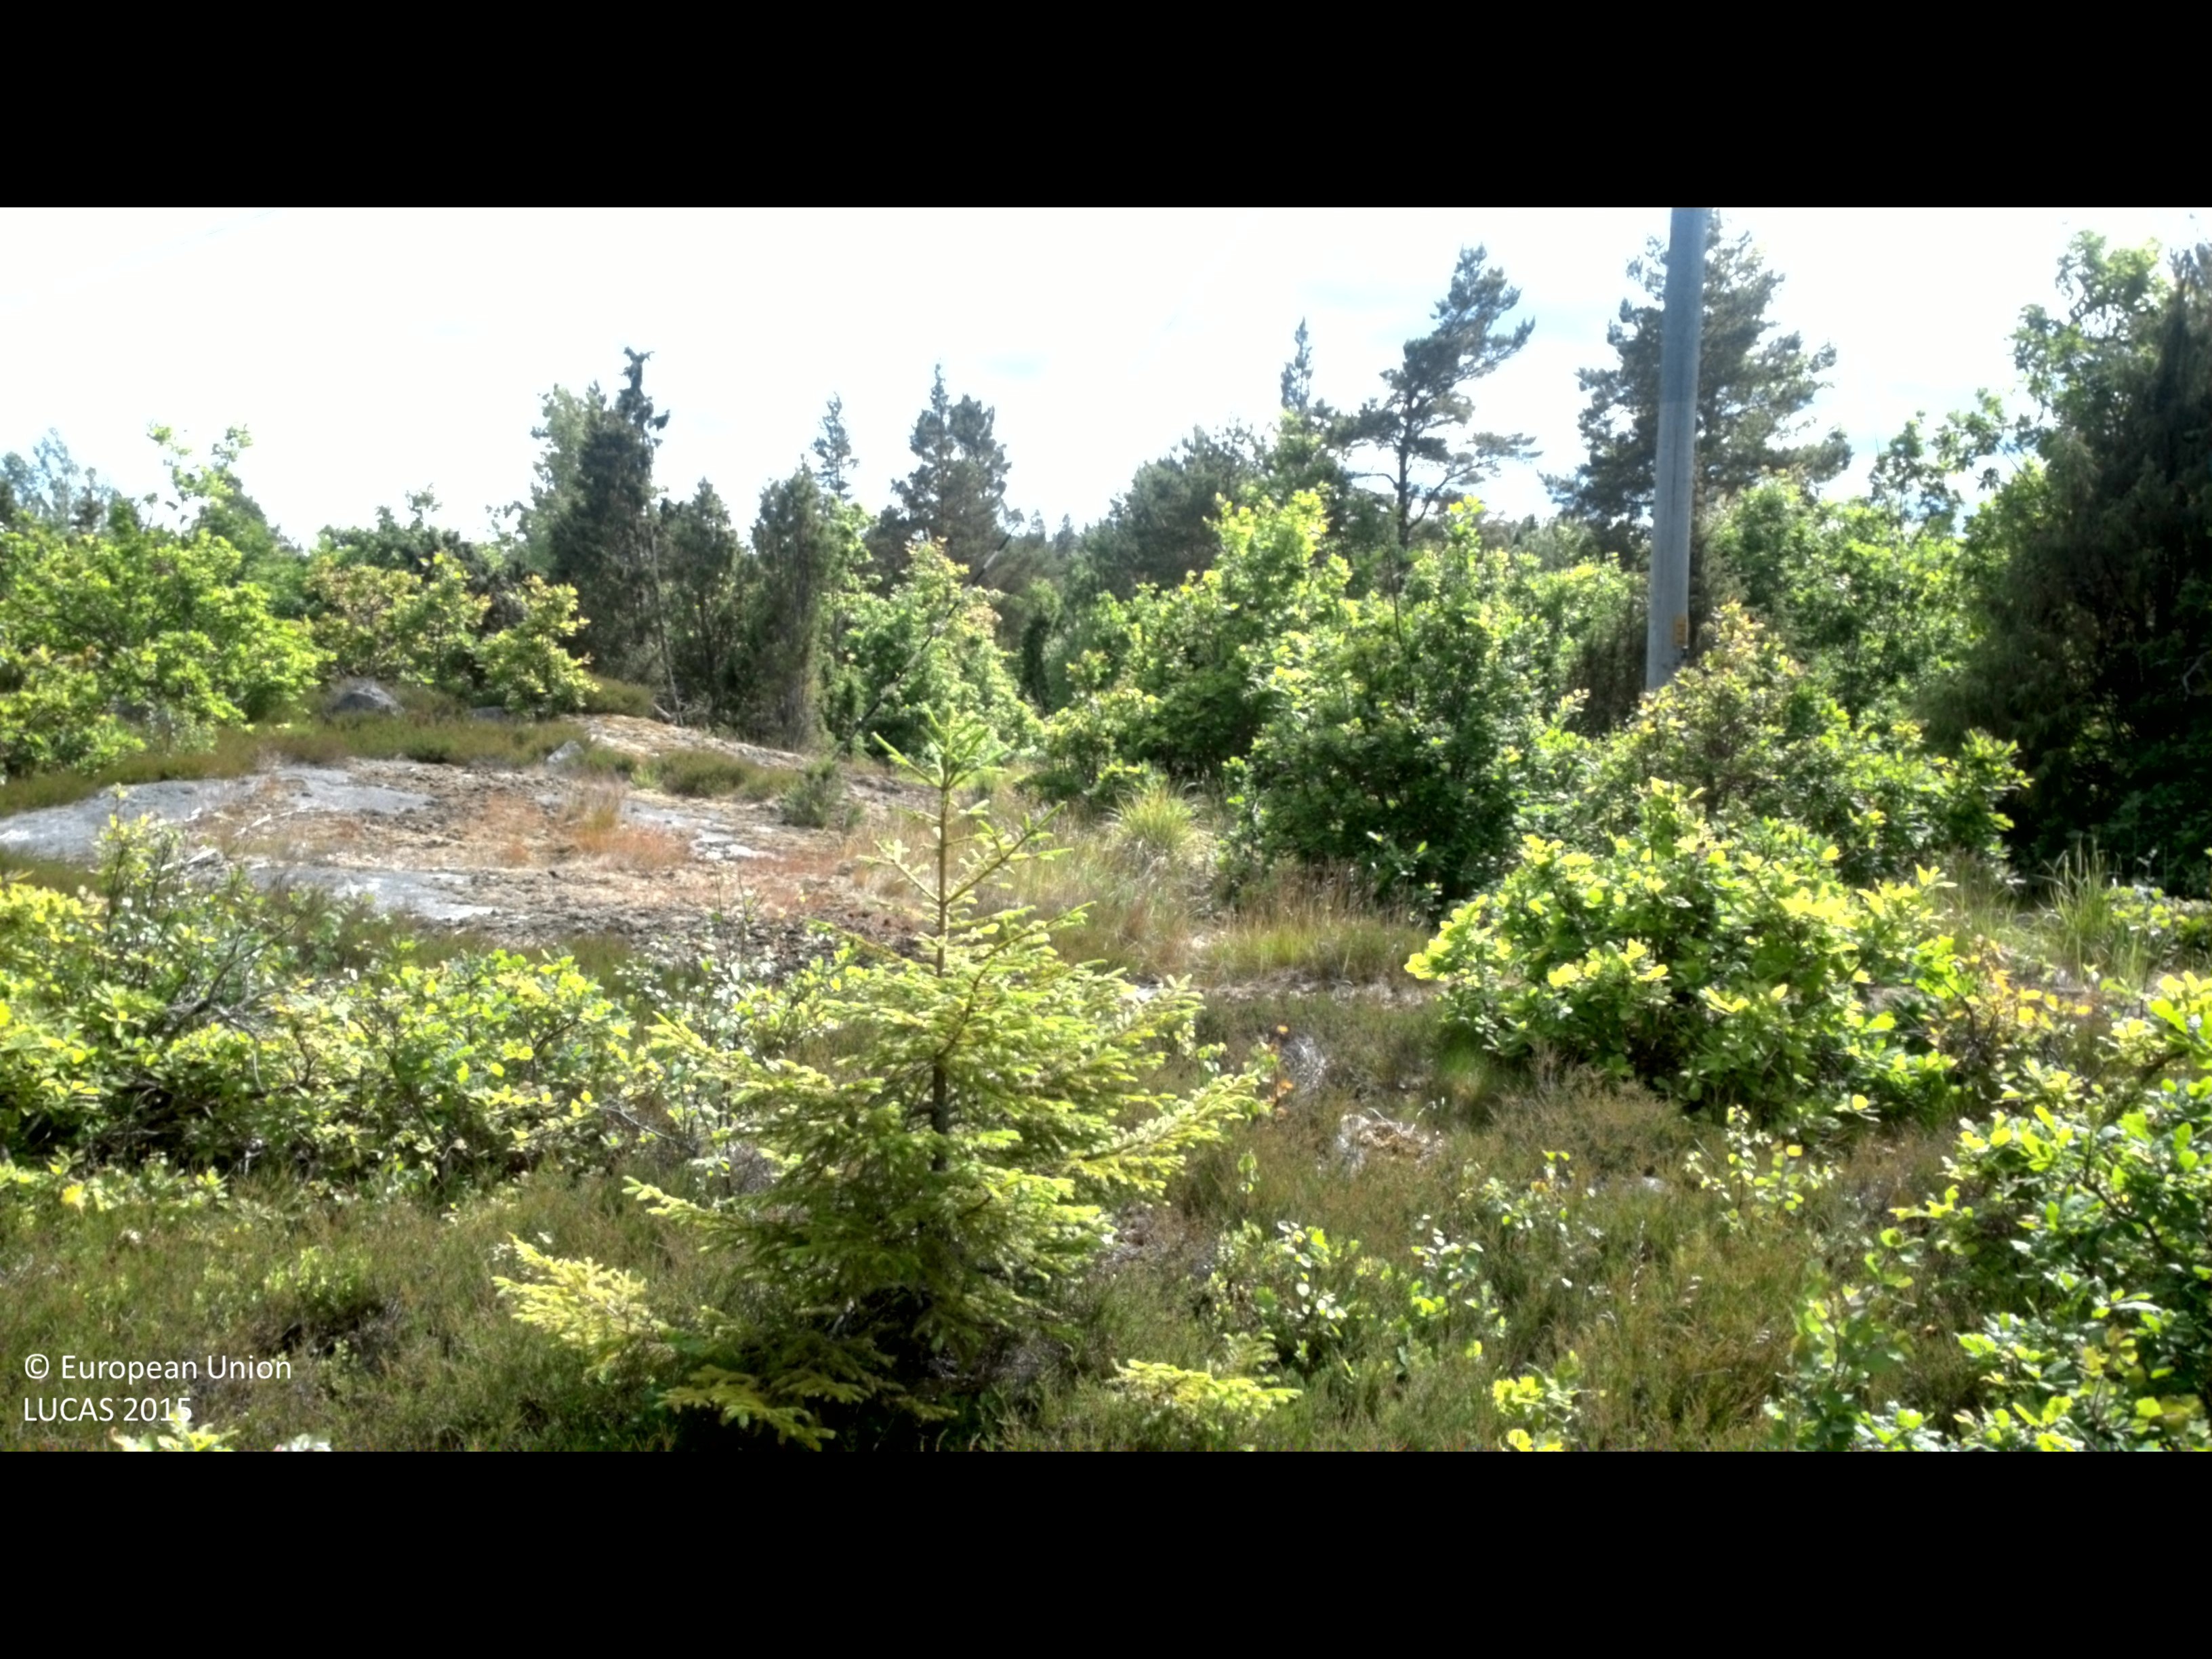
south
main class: Woodland
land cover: Other mixed woodland
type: boreal forest
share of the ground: 50 - 75 %
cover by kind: broadleaved forest trees 35 %, coniferous forest trees 30 %, shrubs 20 %, lichens and mosses 10 %, consolidated bare surface 5 %
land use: Forestry
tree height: > 5 m
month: June
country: SE
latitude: 57.7112
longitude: 16.6624
